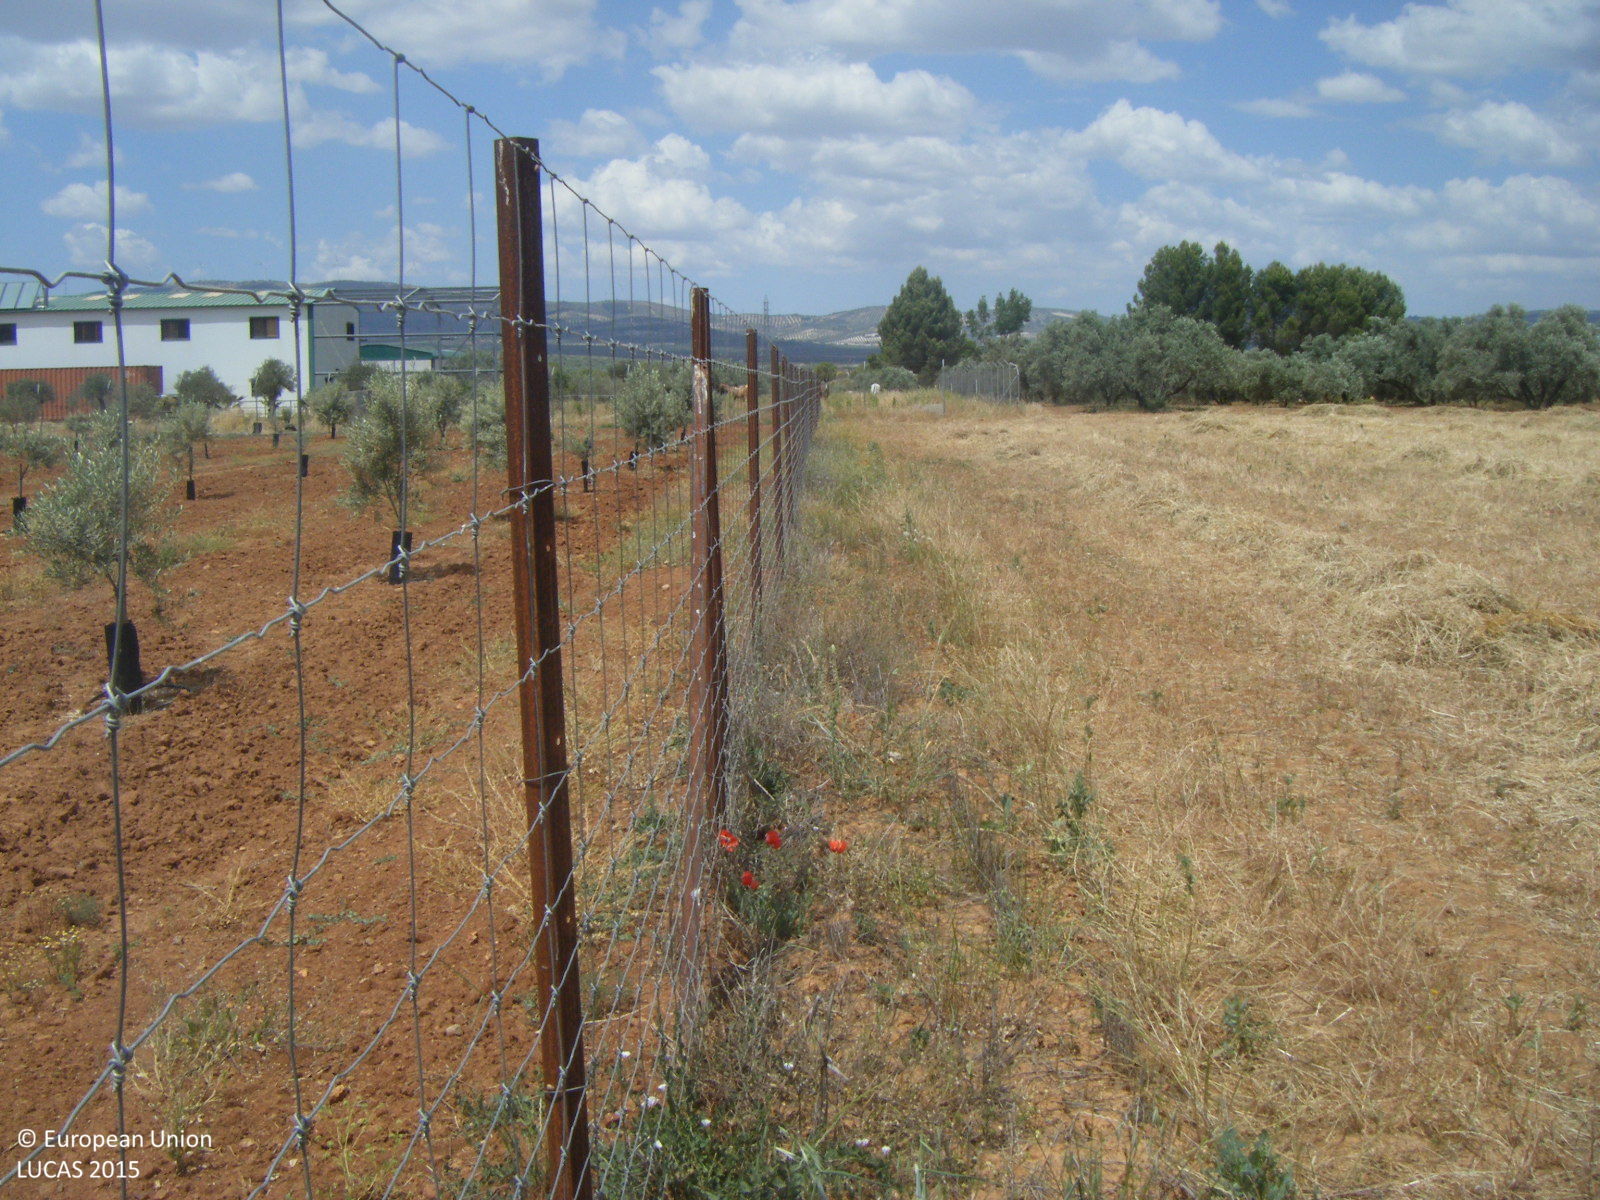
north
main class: Cropland
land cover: Olive groves
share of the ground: < 10 %
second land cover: Other bare soil
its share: > 75 %
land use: Agriculture (excluding fallow land and kitchen gardens)
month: May
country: ES
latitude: 37.0822
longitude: -4.4289
